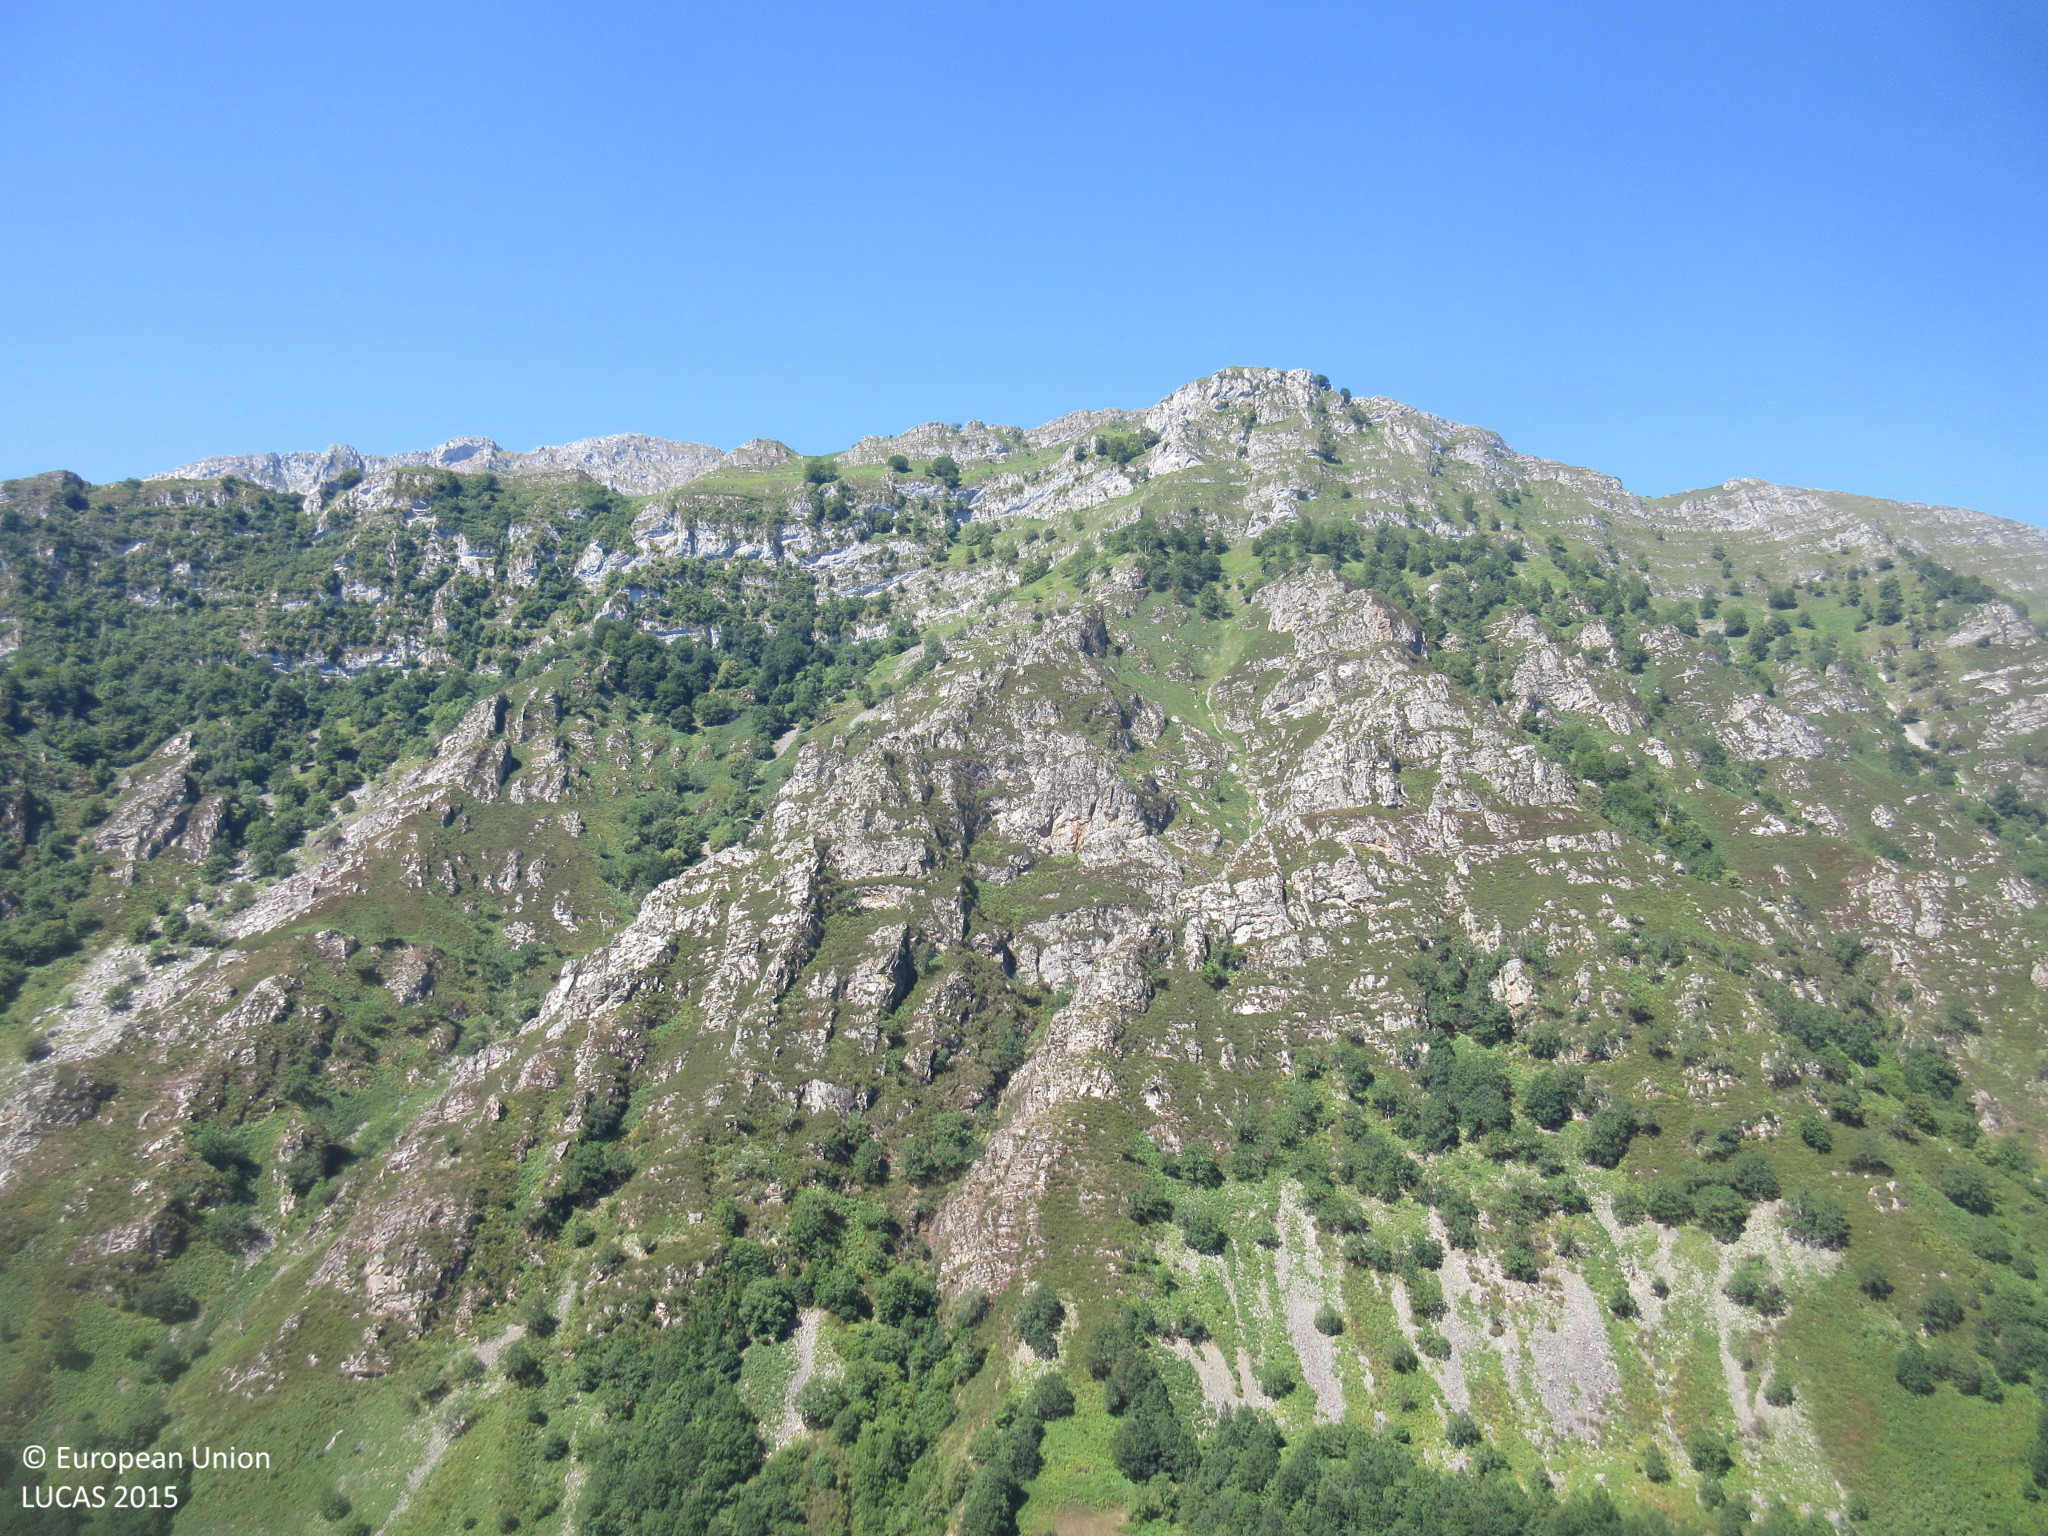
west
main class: Grassland
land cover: Grassland without tree/shrub cover
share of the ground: > 75 %
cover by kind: herbaceous plants 95 %, consolidated bare surface 5 %
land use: Agriculture (excluding fallow land and kitchen gardens)
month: July
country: ES
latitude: 43.2226
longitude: -5.2029
